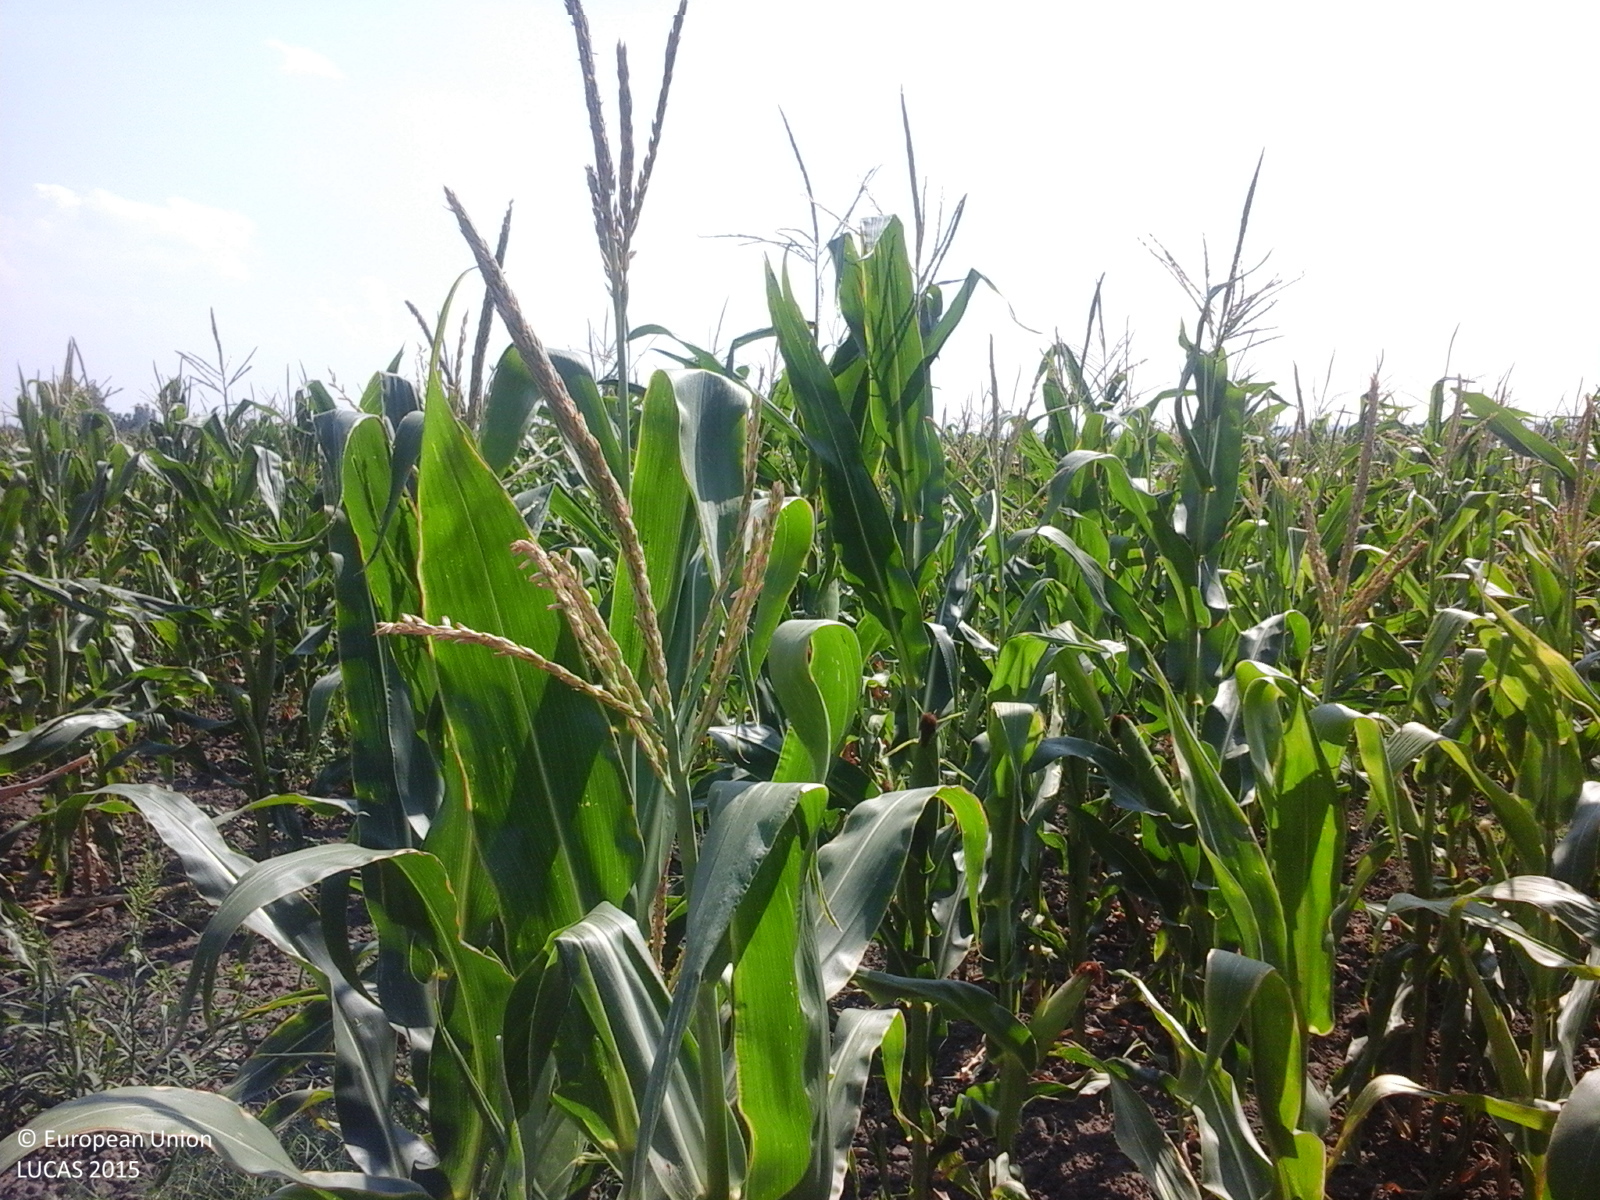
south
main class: Cropland
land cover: Maize
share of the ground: > 75 %
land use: Agriculture (excluding fallow land and kitchen gardens)
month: July
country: RO
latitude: 46.0031
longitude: 27.4741
